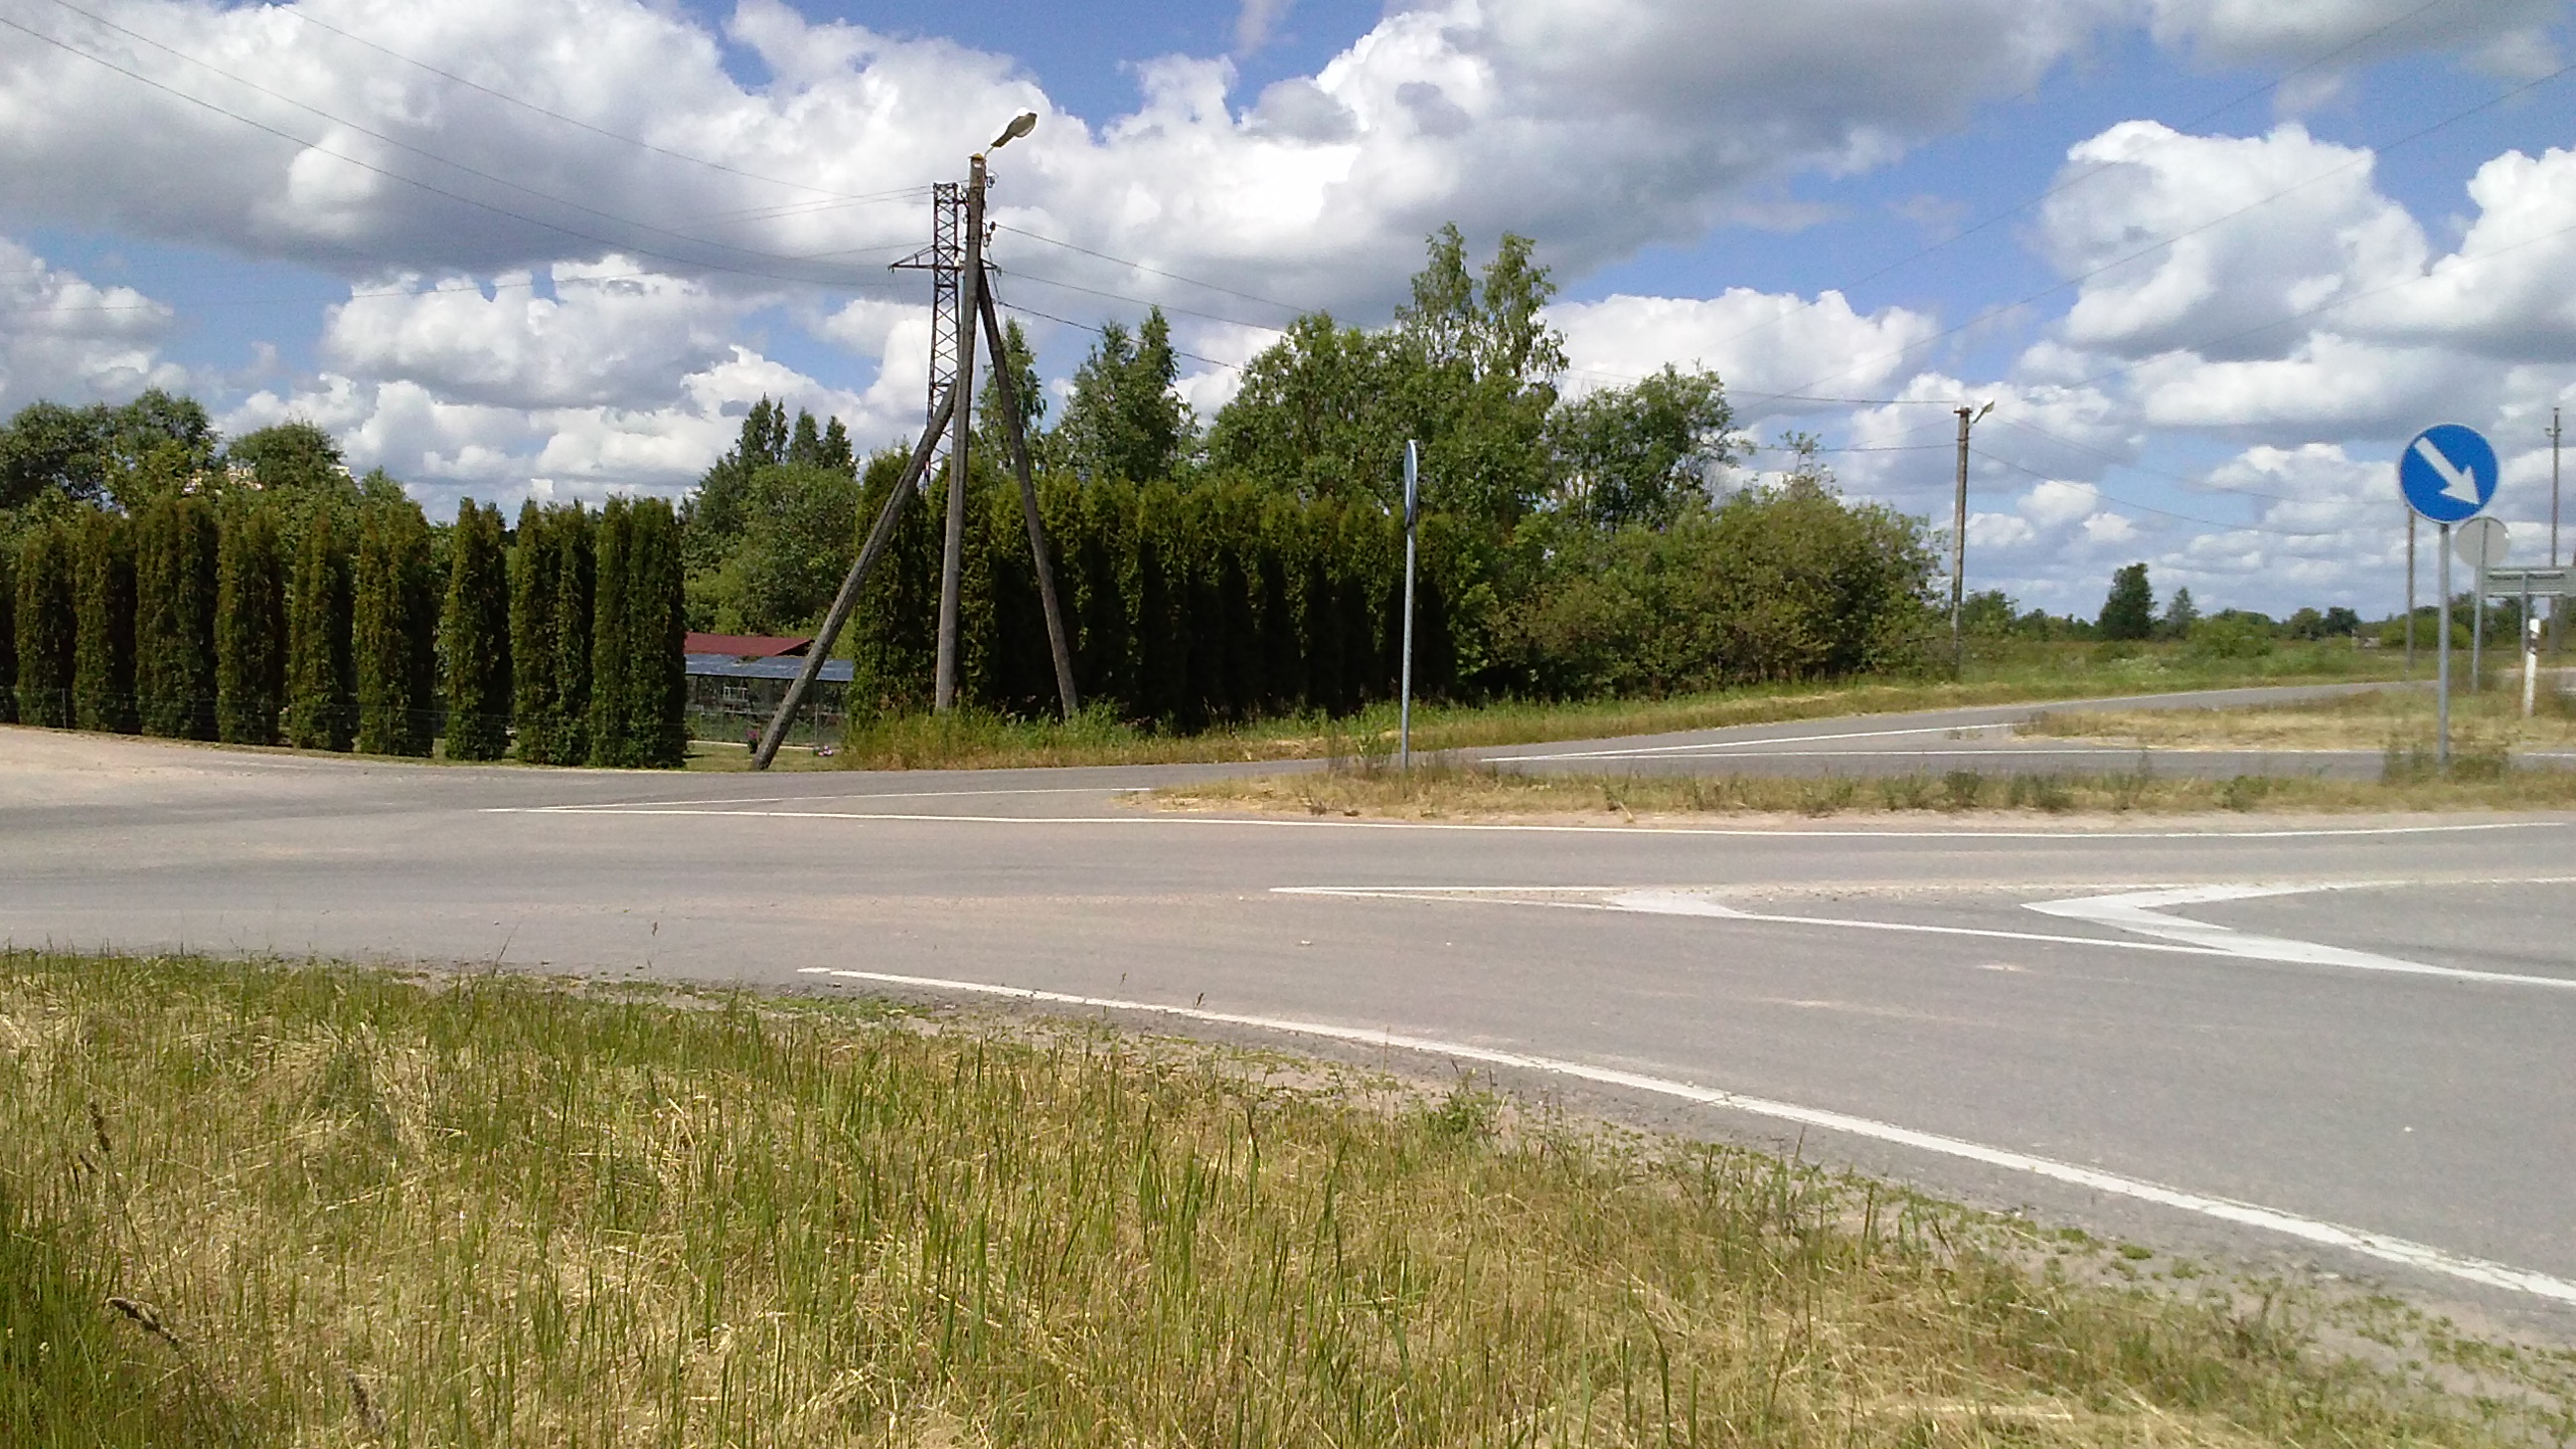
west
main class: Grassland
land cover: Grassland without tree/shrub cover
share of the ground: > 75 %
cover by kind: herbaceous plants 100 %
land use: Road transport
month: June
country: LV
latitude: 56.5308
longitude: 27.6962
